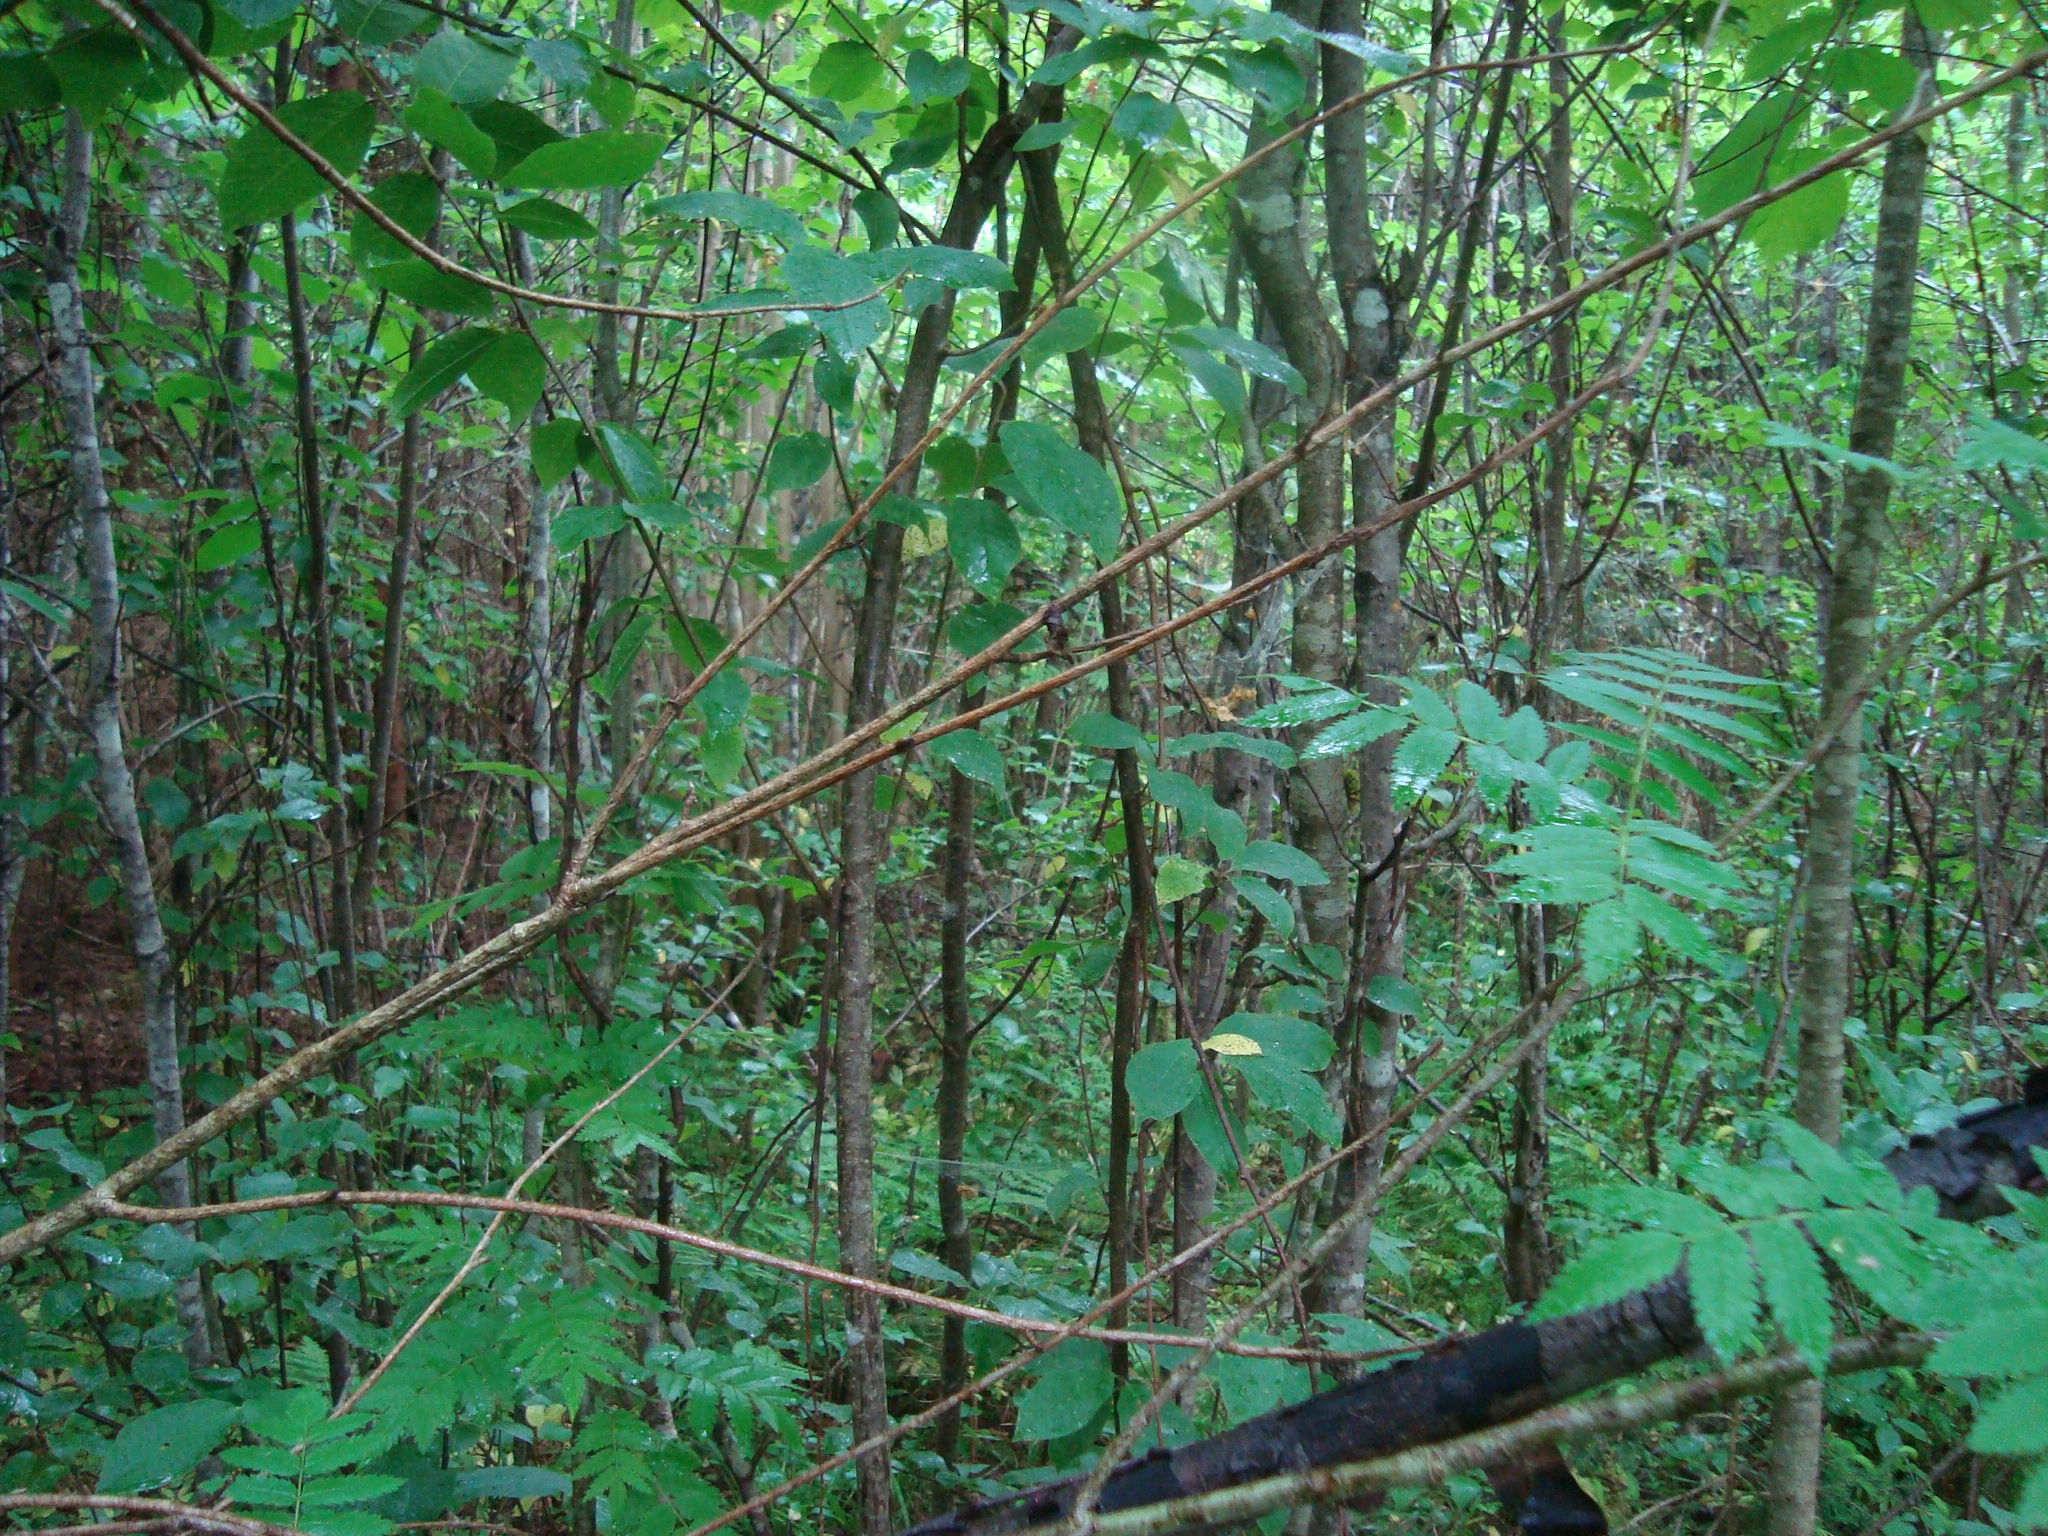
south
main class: Woodland
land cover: Broadleaved woodland
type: non-riverine alder, birch or aspen forest
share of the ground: > 75 %
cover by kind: broadleaved forest trees 85 %, coniferous forest trees 5 %, shrubs 5 %, herbaceous plants 5 %
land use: Forestry
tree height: > 5 m
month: June
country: LV
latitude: 57.0315
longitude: 25.6930
